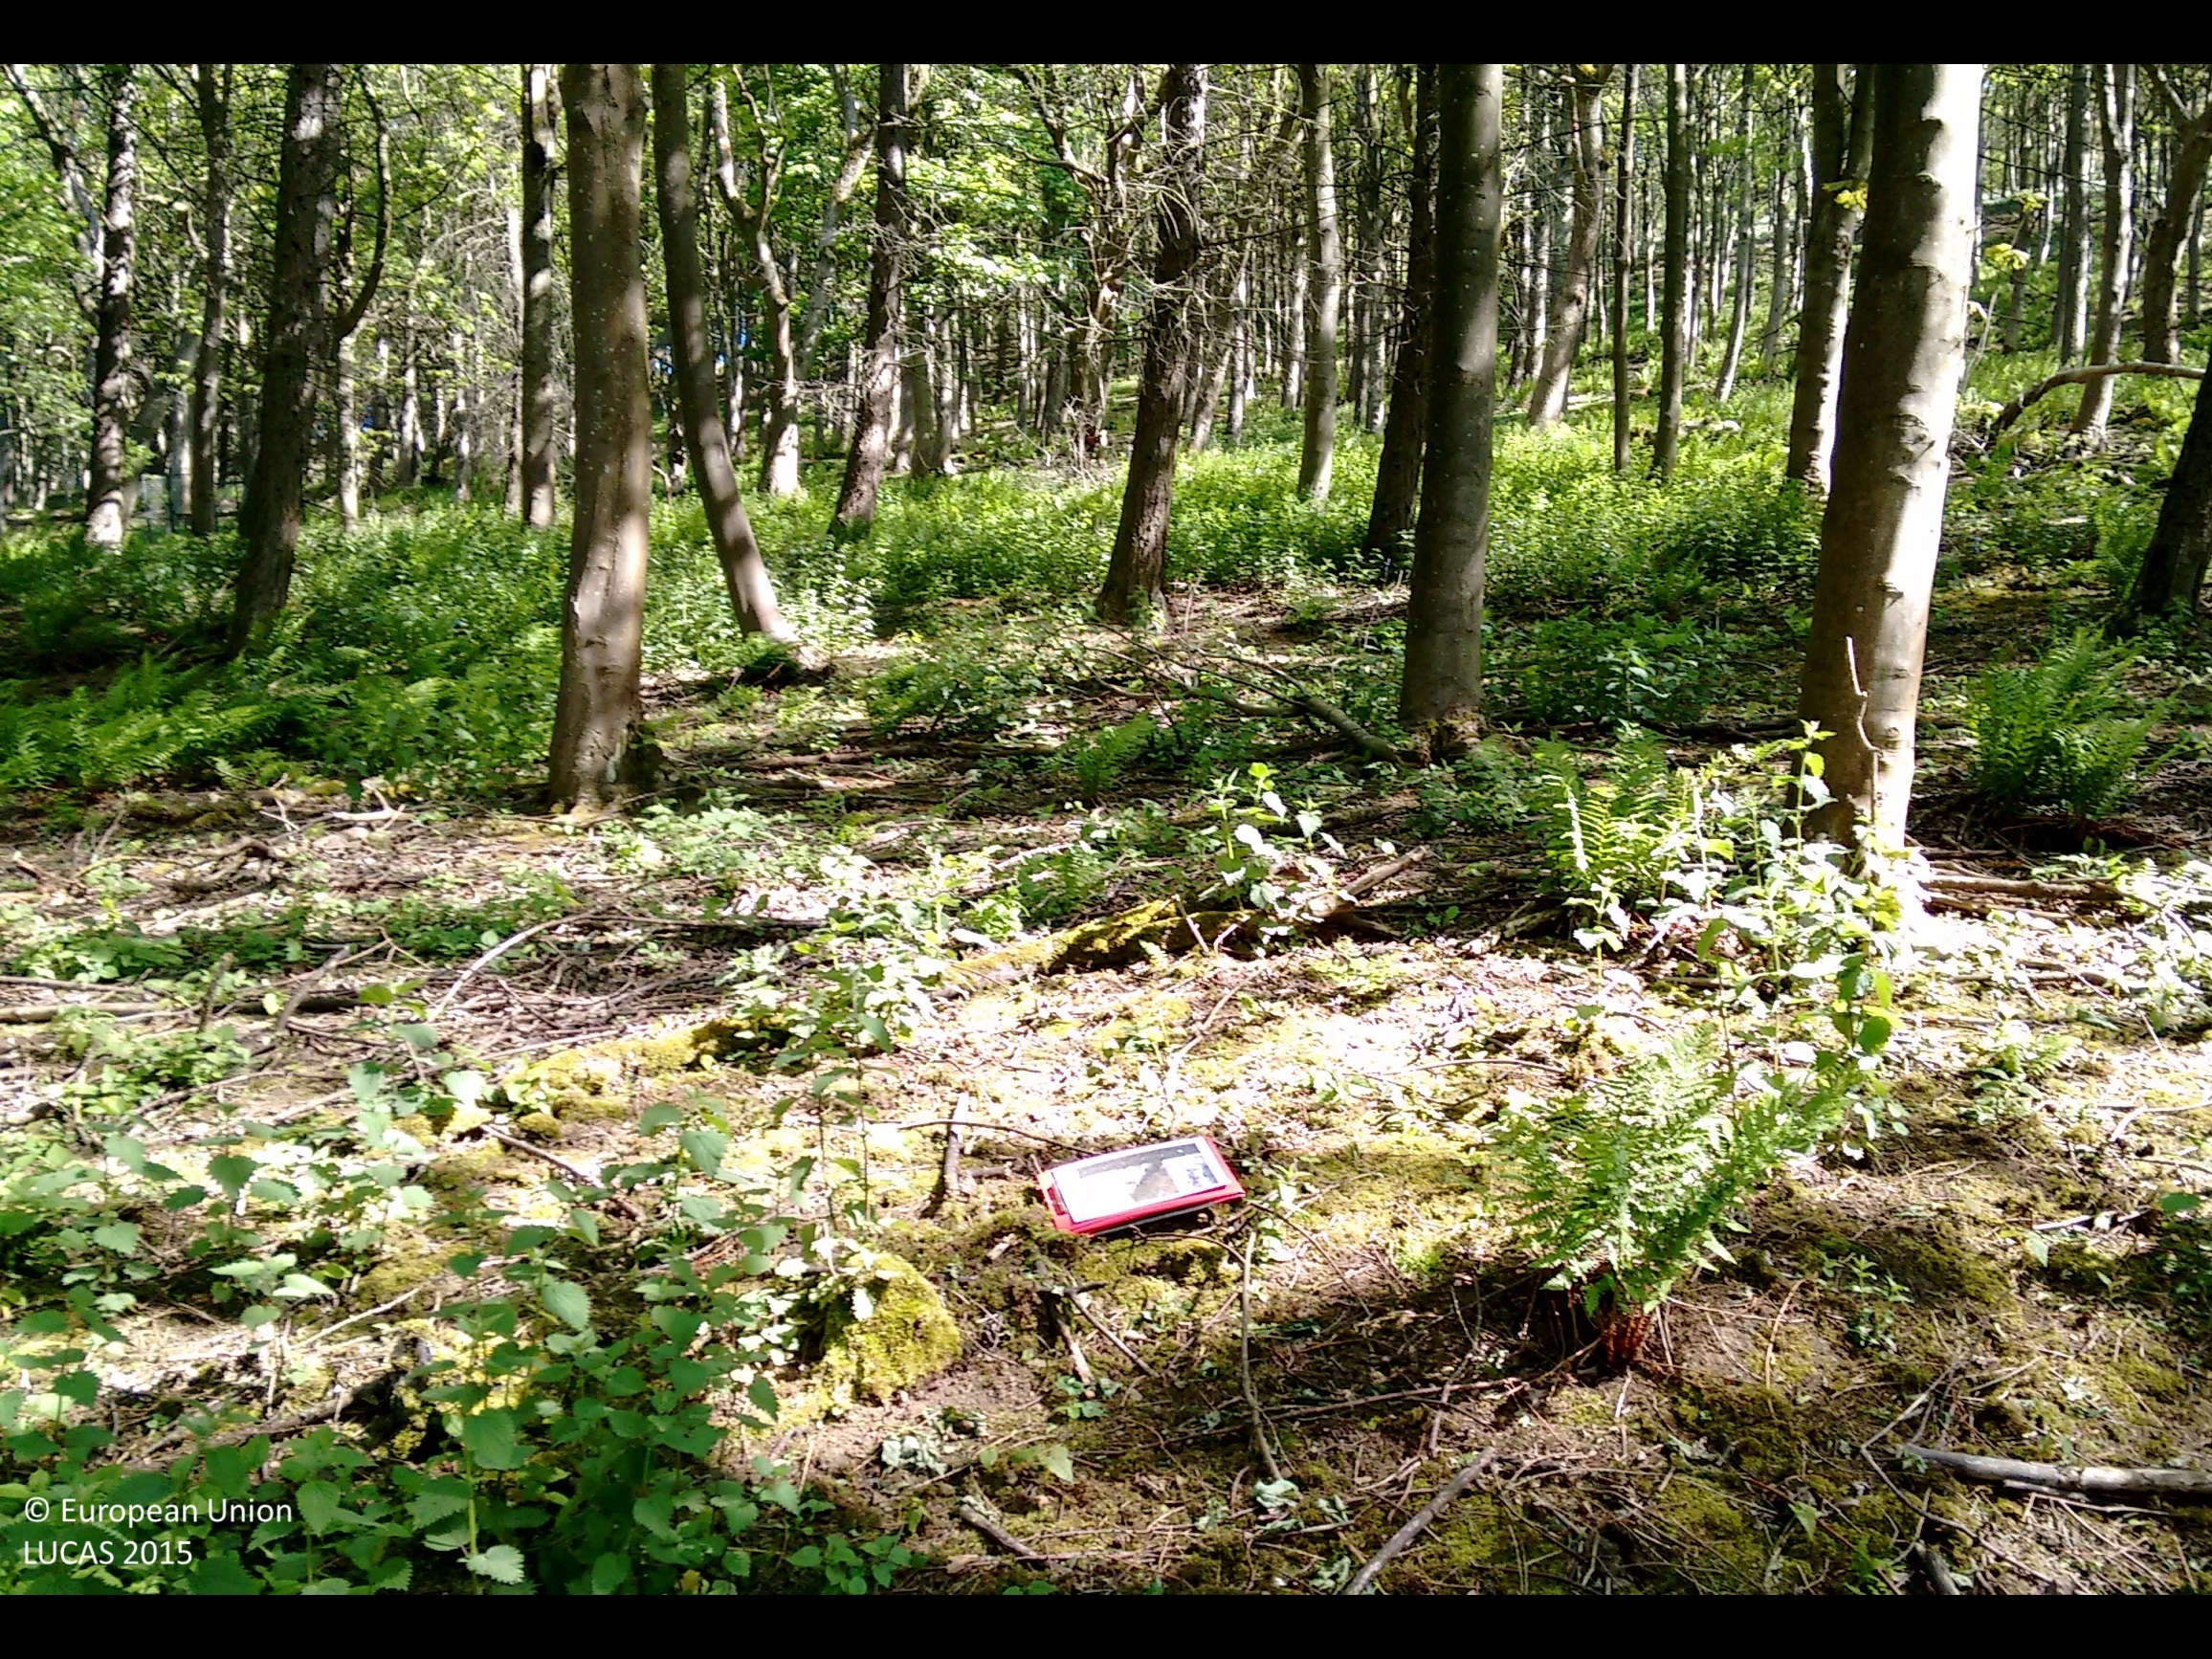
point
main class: Woodland
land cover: Broadleaved woodland
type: mesophytic deciduous forest
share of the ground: > 75 %
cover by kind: broadleaved forest trees 75 %, coniferous forest trees 25 %
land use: Forestry
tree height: > 5 m
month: June
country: GB
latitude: 54.3211
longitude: -1.9083
